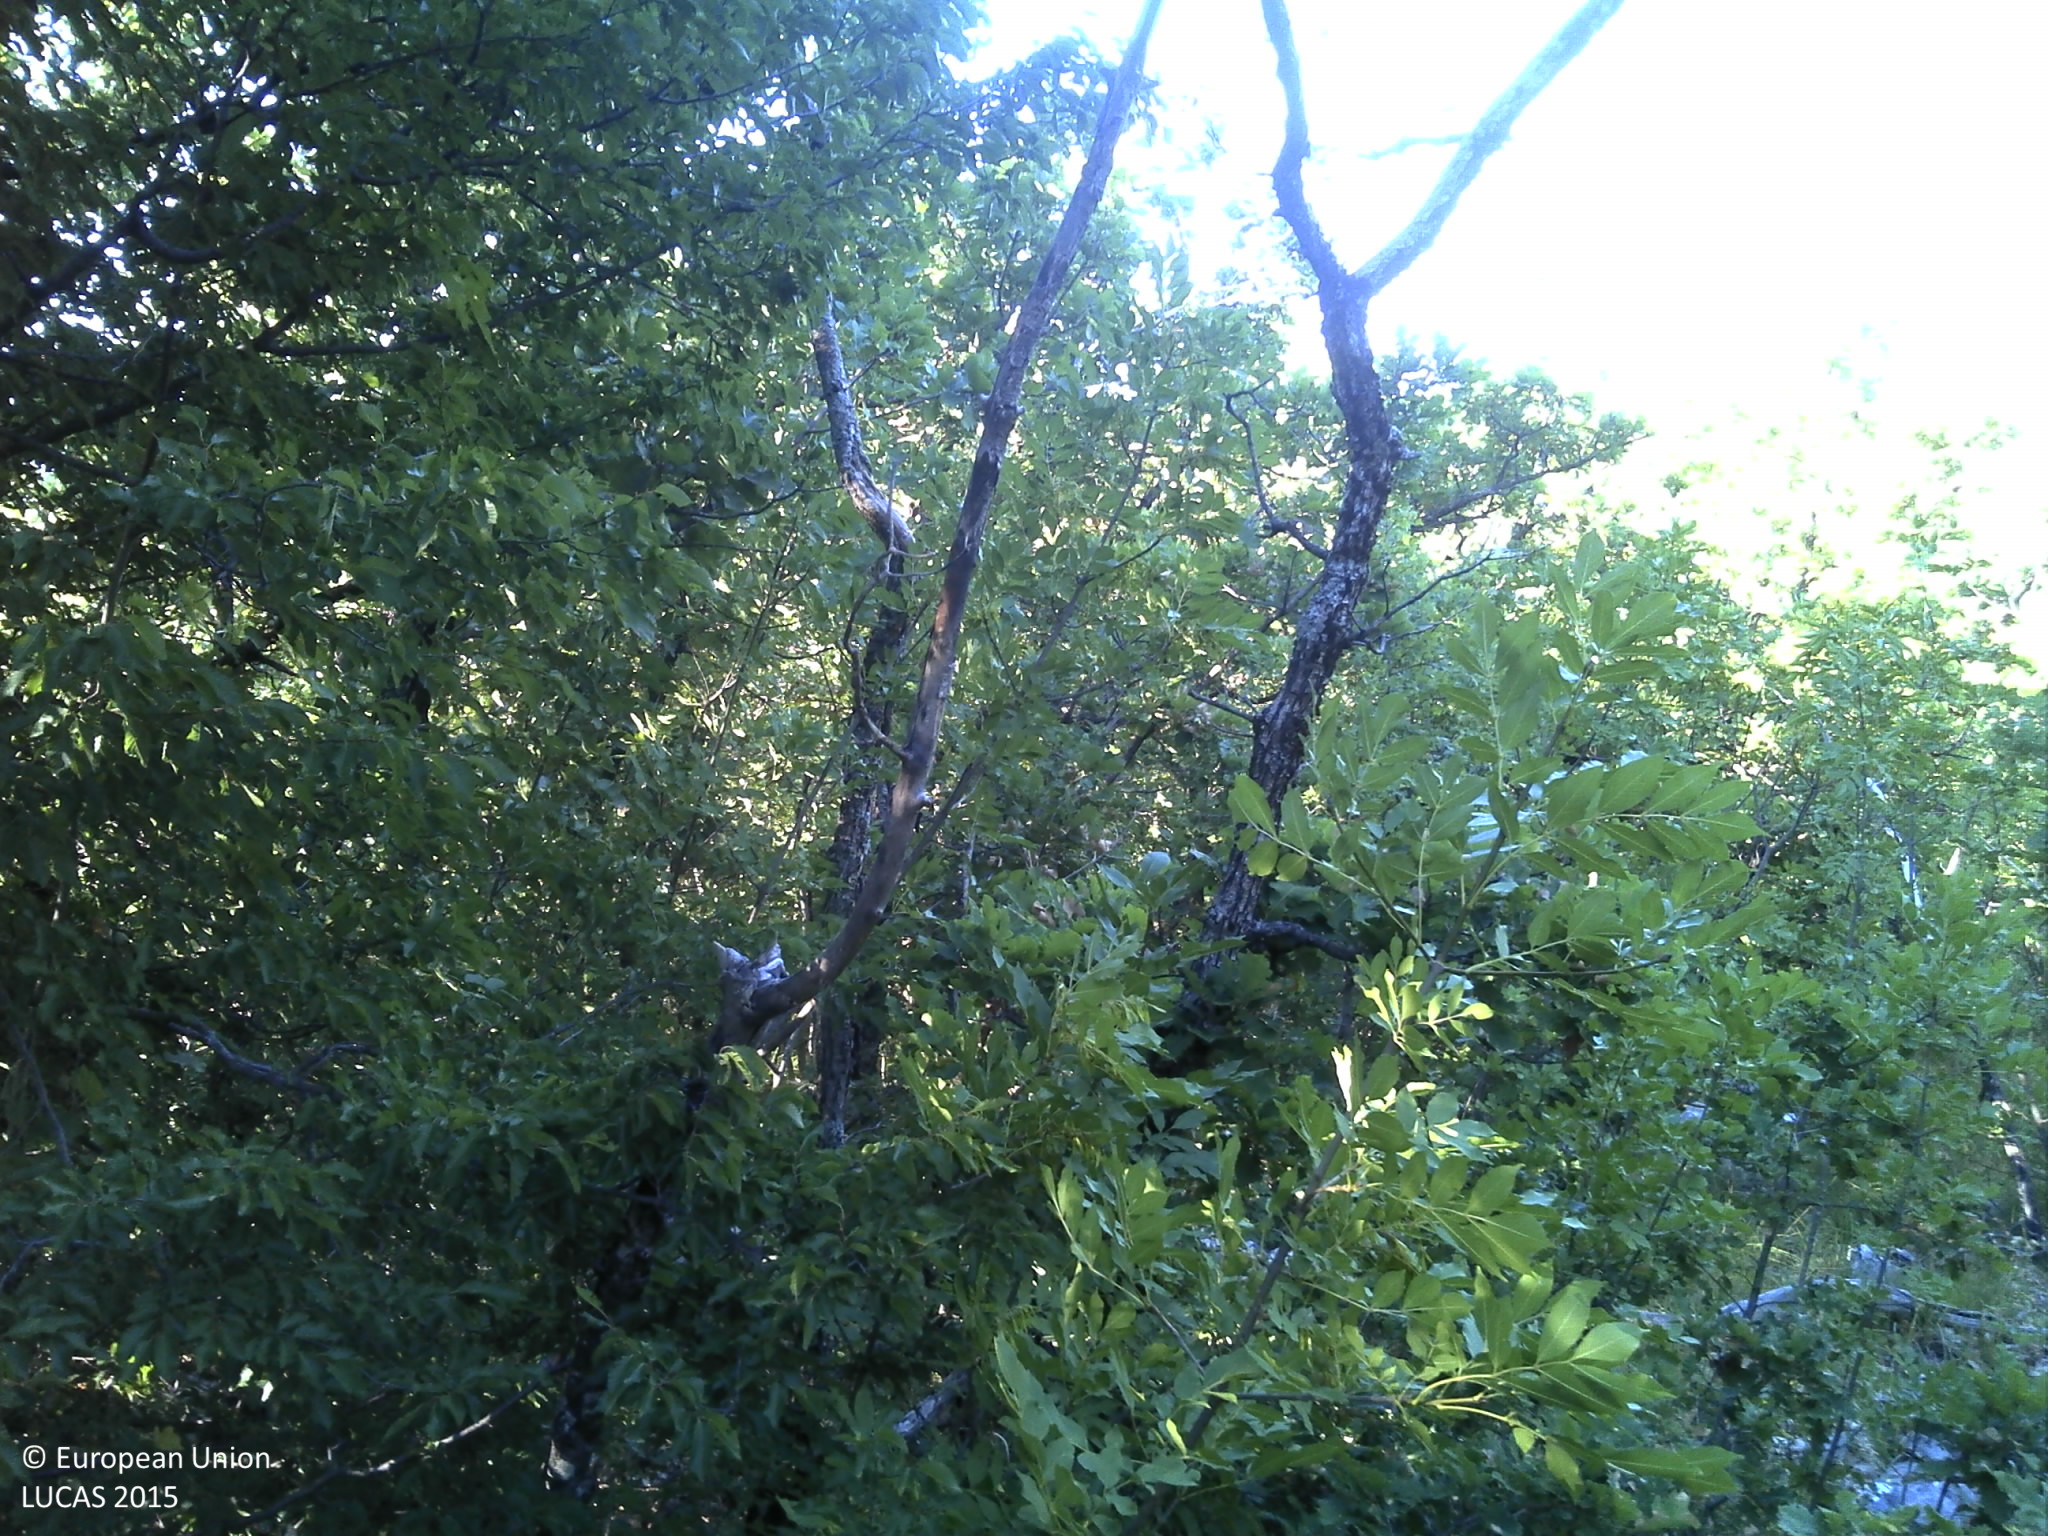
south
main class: Woodland
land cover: Other mixed woodland
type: thermophilous deciduous forest
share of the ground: > 75 %
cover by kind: broadleaved forest trees 55 %, coniferous forest trees 20 %, shrubs 10 %, herbaceous plants 10 %, consolidated bare surface 5 %
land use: Semi-natural and natural areas not in use
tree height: > 5 m
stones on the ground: < 10 %
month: July
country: HR
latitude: 43.5392
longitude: 16.9344
